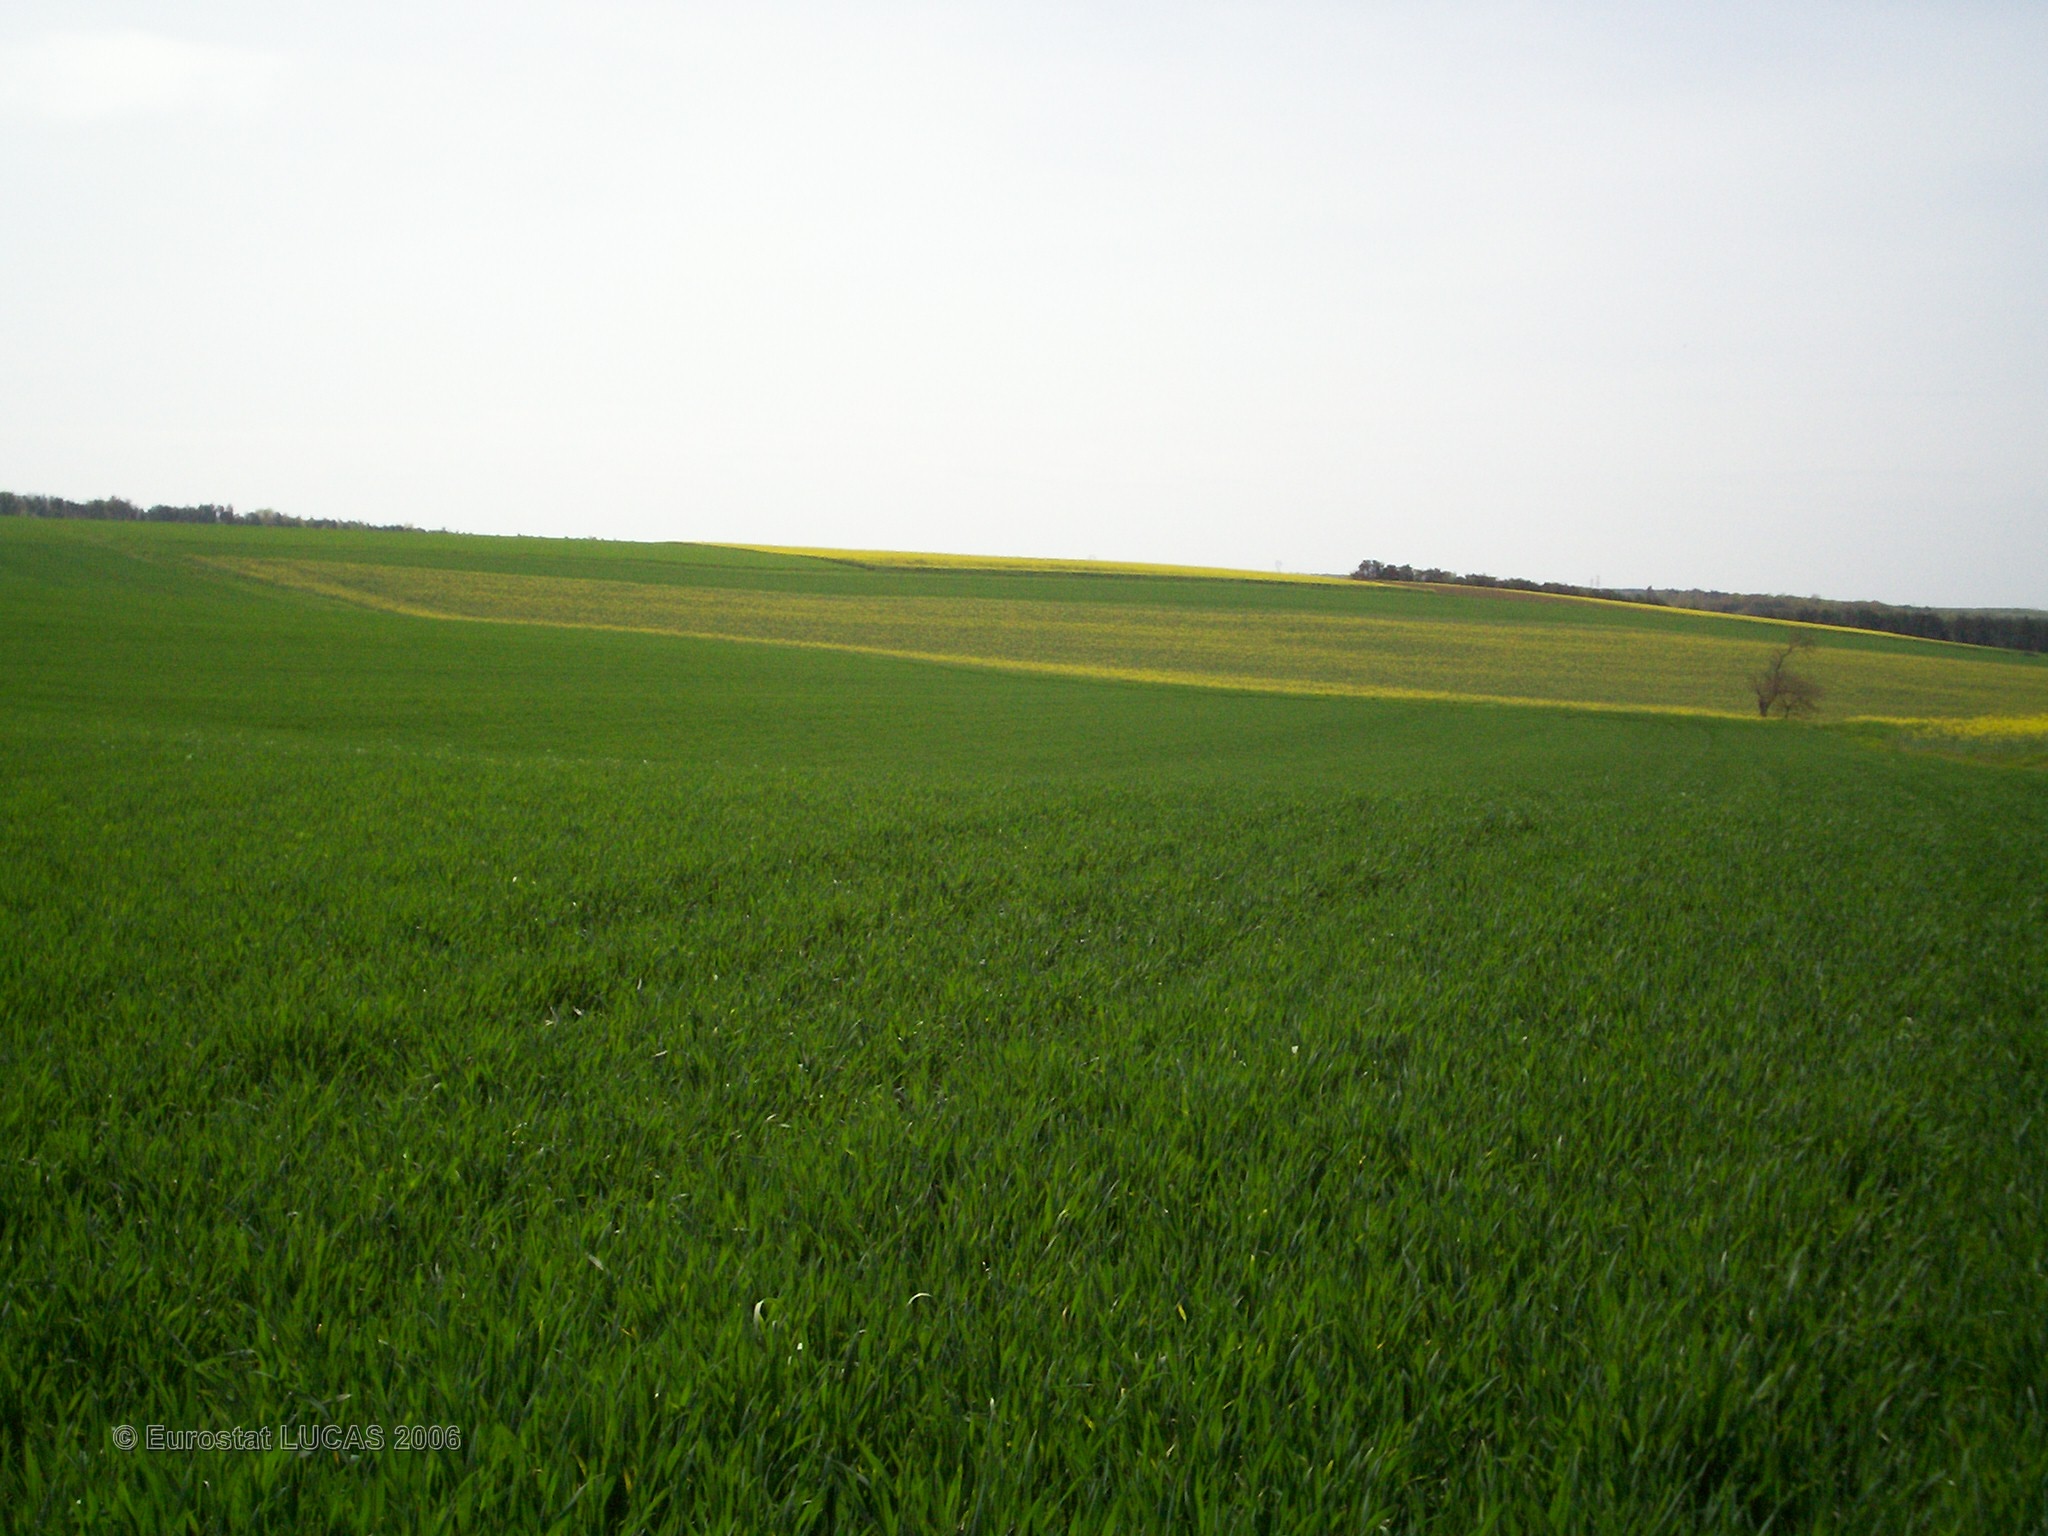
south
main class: Cropland
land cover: Common wheat
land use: Agriculture (excluding fallow land and kitchen gardens)
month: May
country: FR
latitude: 47.8884
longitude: 3.8310
